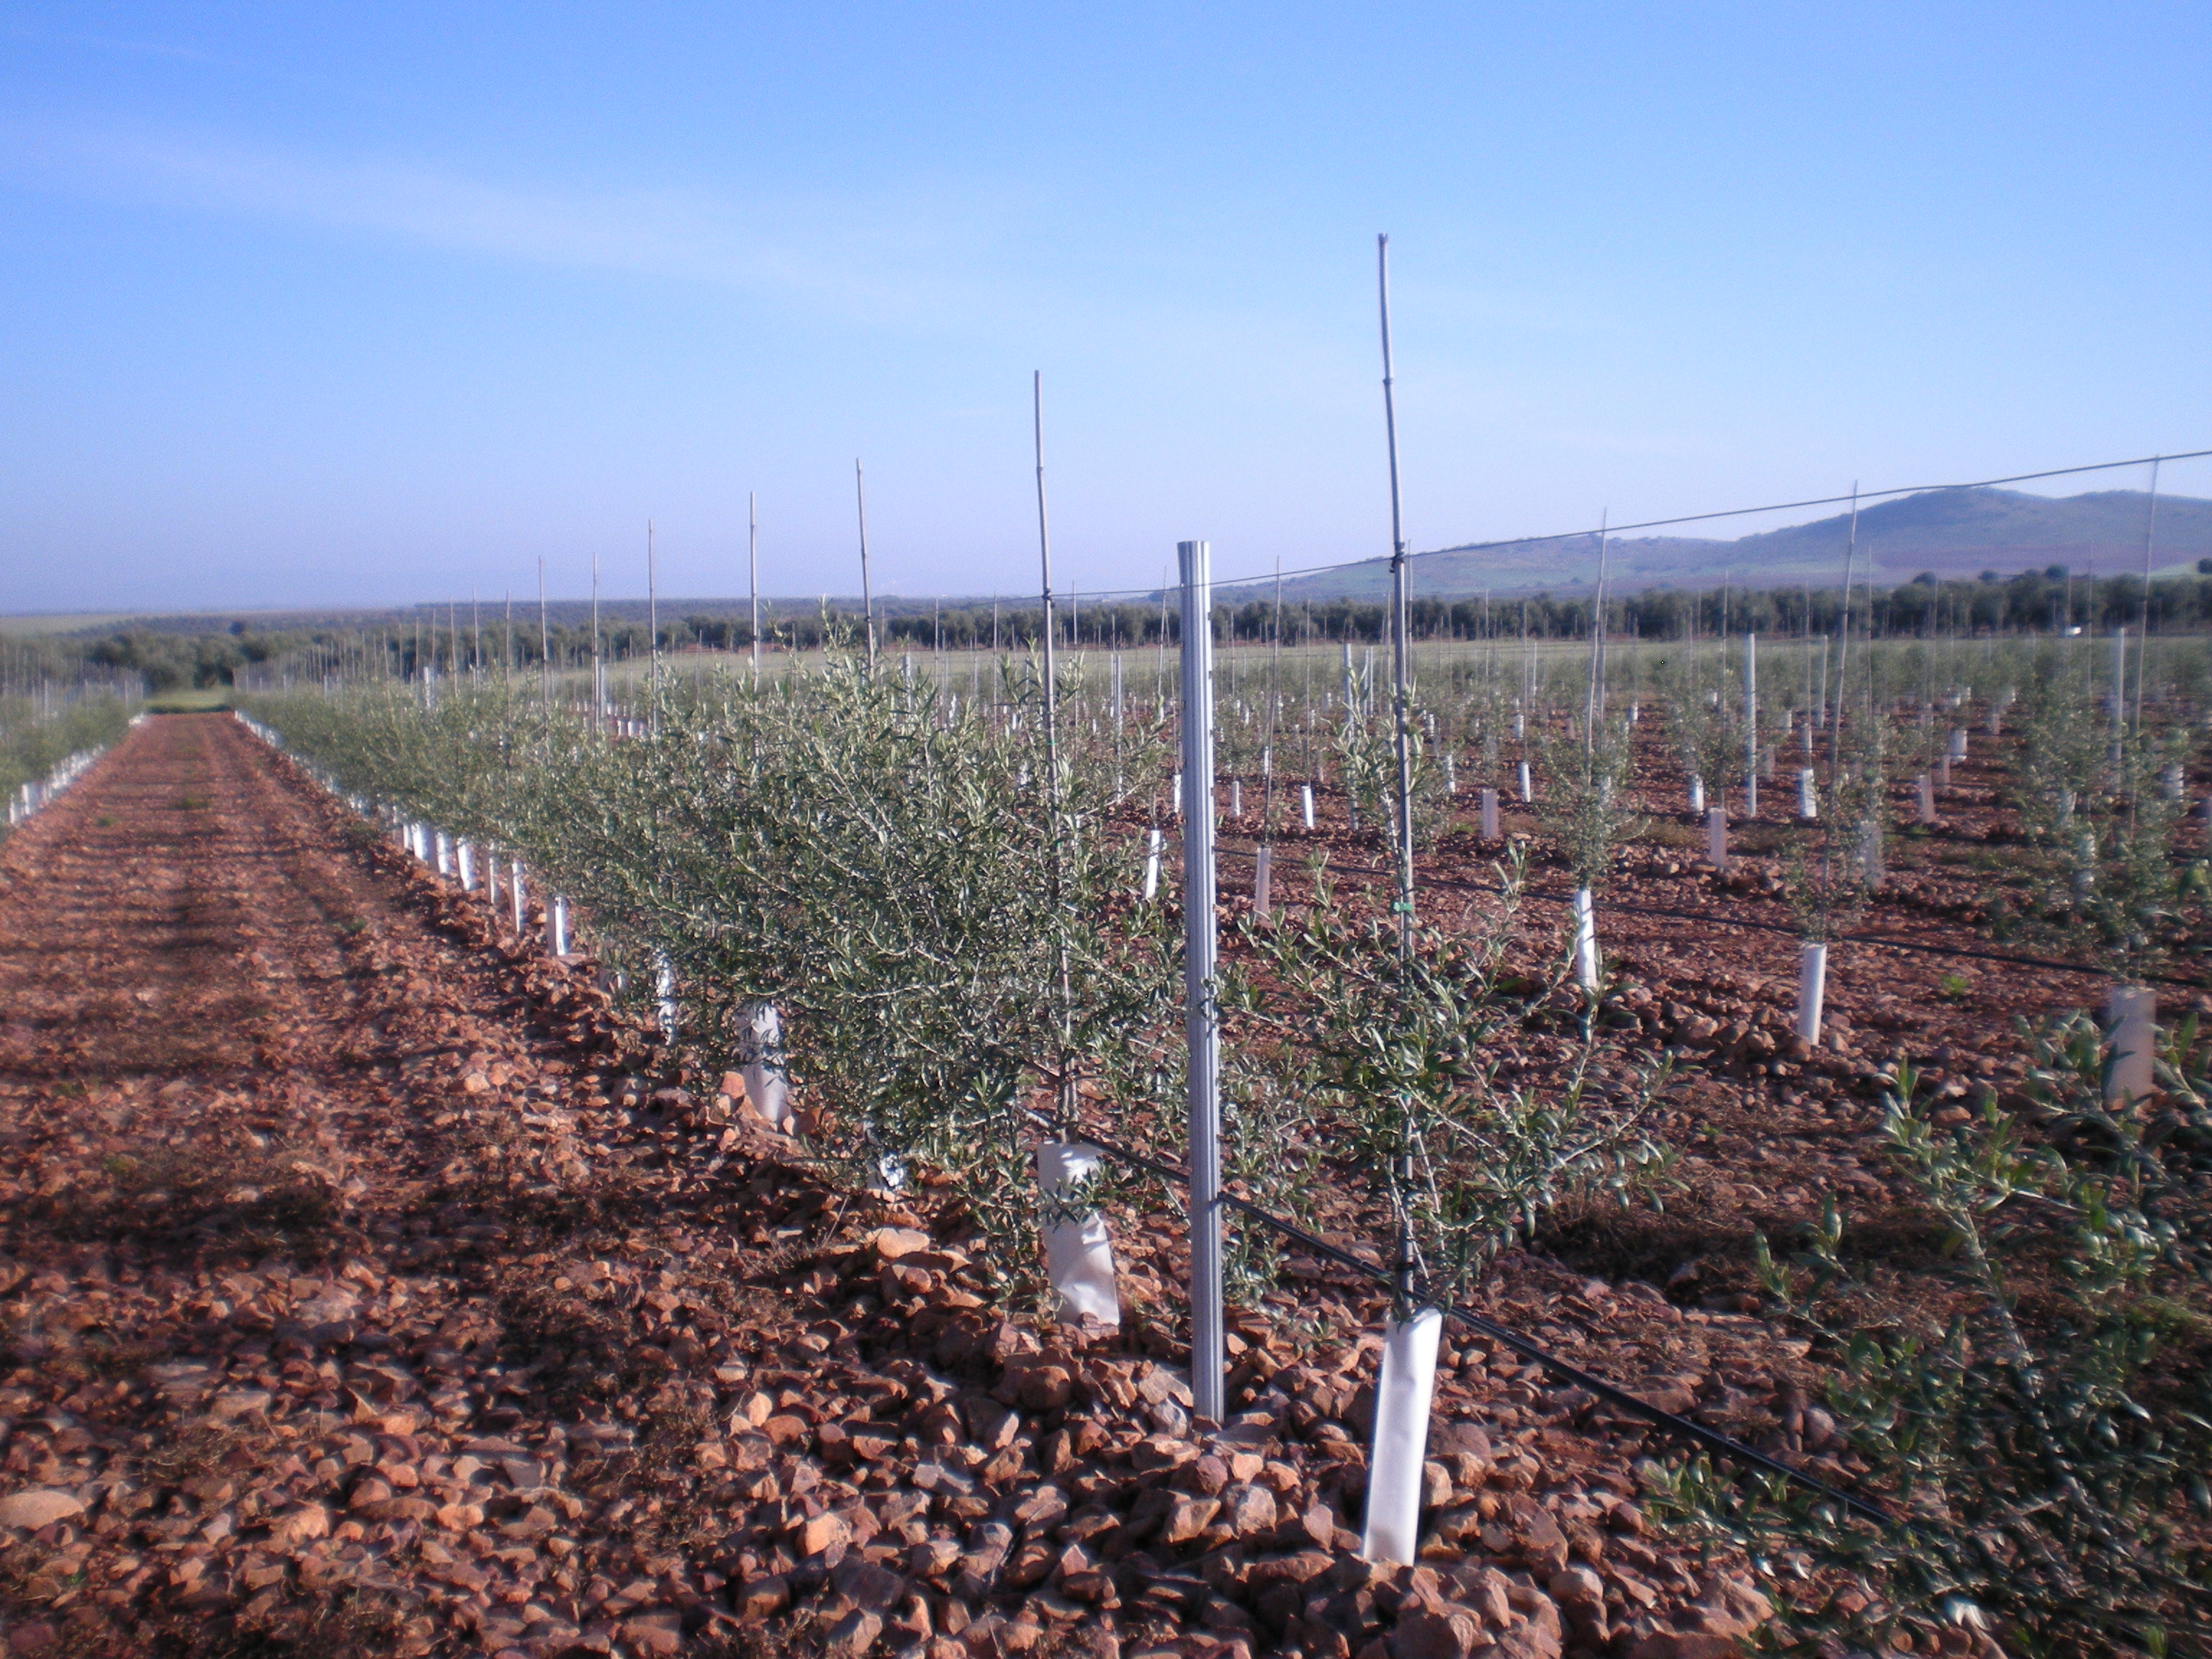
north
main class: Cropland
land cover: Olive groves
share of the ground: 10 - 25 %
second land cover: Other bare soil
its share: > 75 %
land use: Agriculture (excluding fallow land and kitchen gardens)
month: April
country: ES
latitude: 38.8781
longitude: -3.5821
